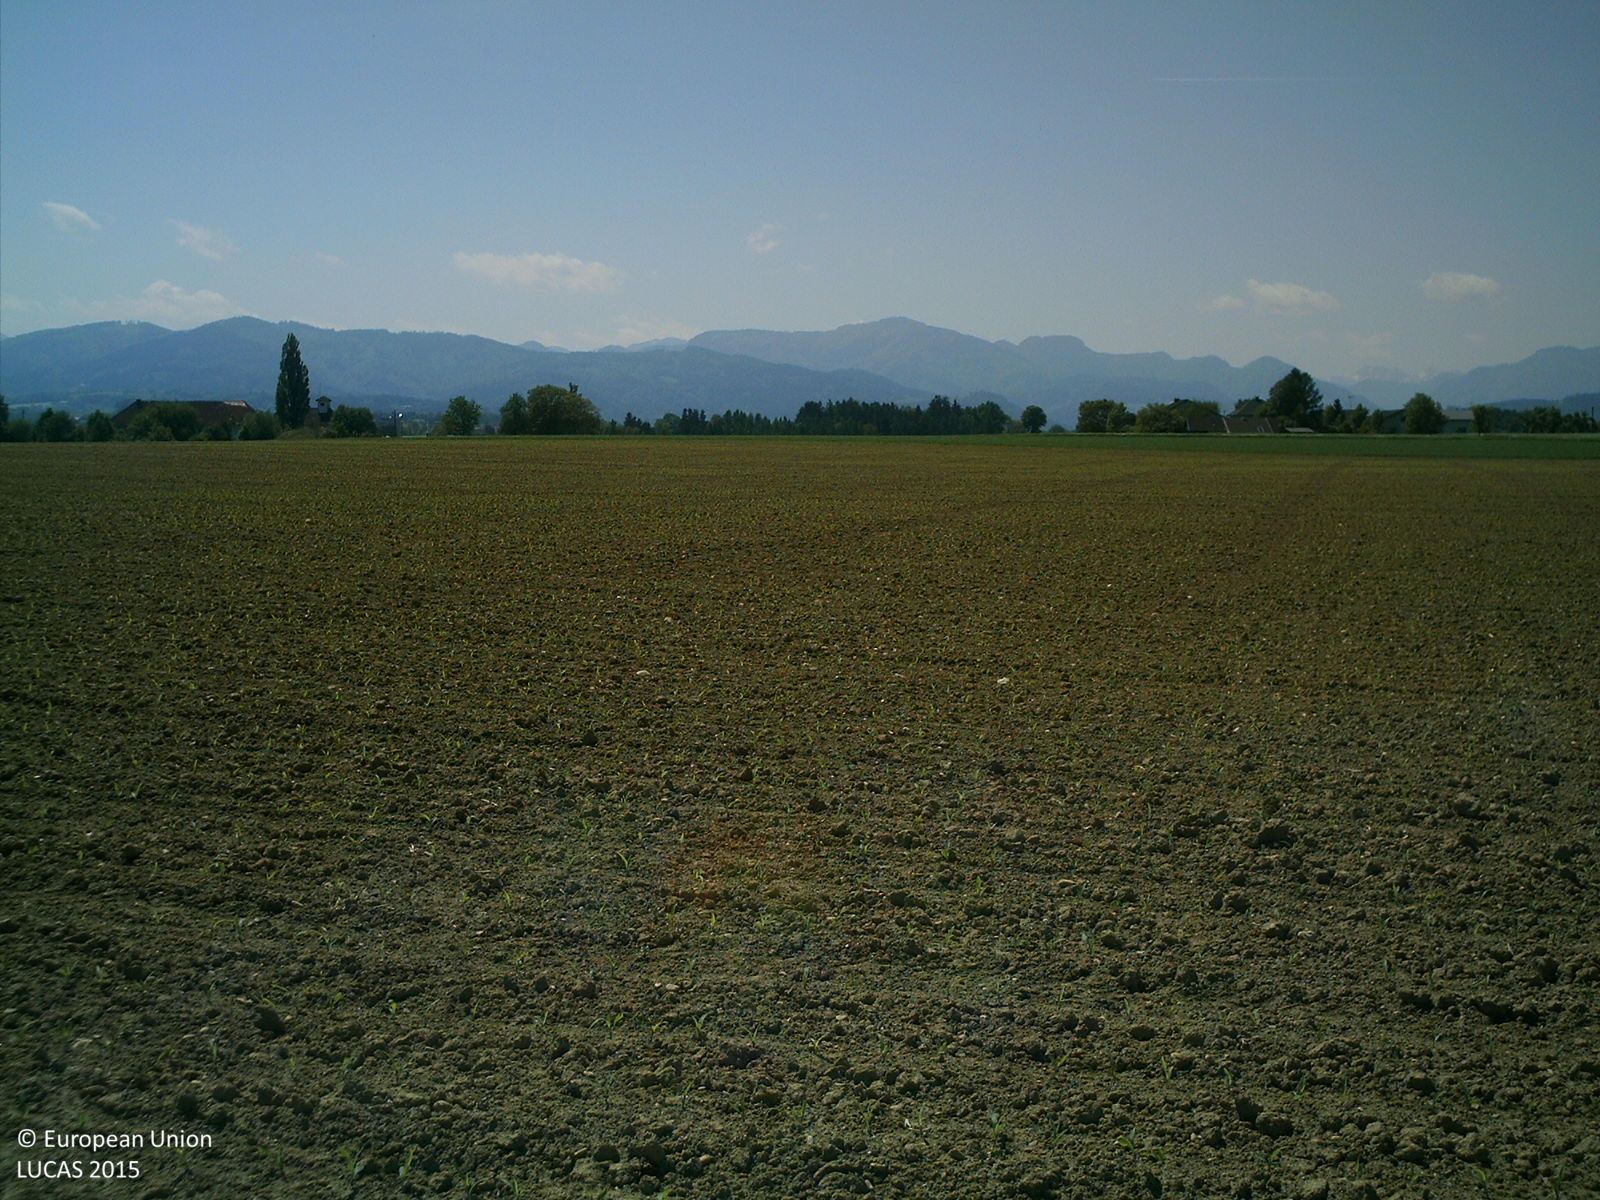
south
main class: Cropland
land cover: Maize
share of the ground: < 10 %
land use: Agriculture (excluding fallow land and kitchen gardens)
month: May
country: AT
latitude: 48.0056
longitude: 14.0341
